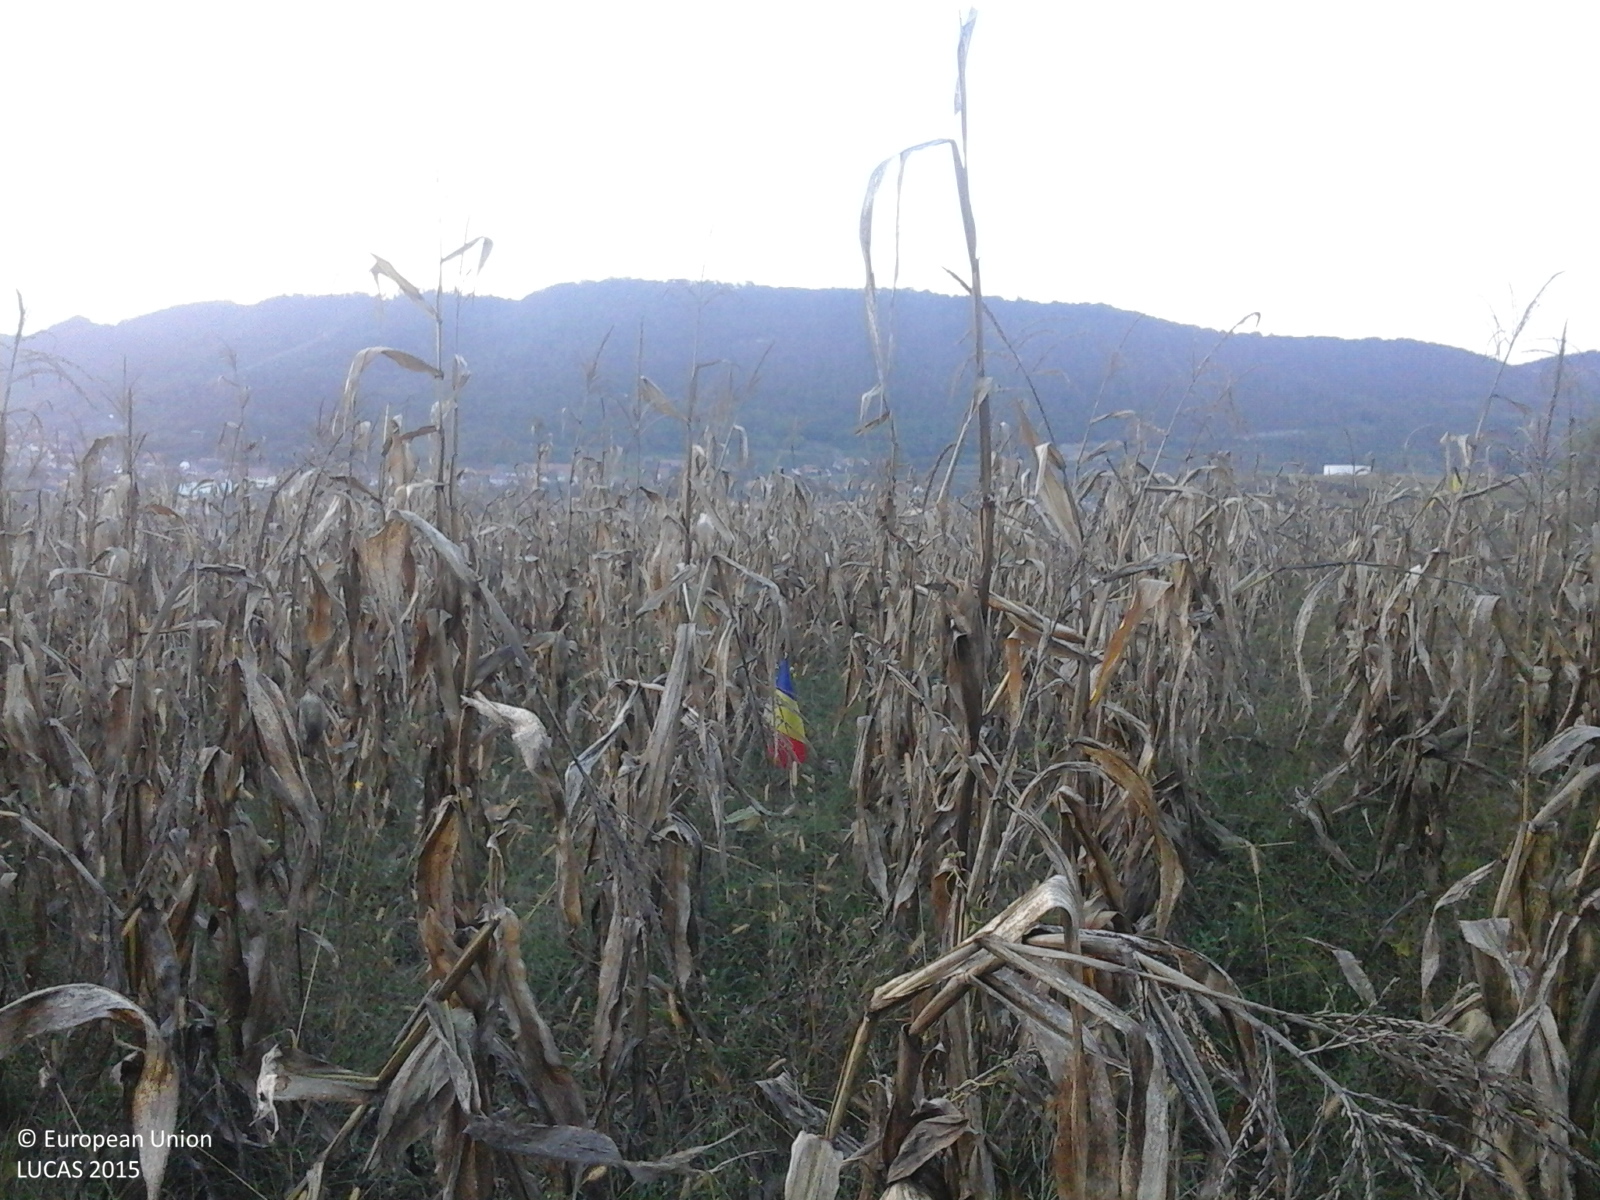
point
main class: Cropland
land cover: Maize
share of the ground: > 75 %
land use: Agriculture (excluding fallow land and kitchen gardens)
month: October
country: RO
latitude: 46.0234
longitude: 24.1703
